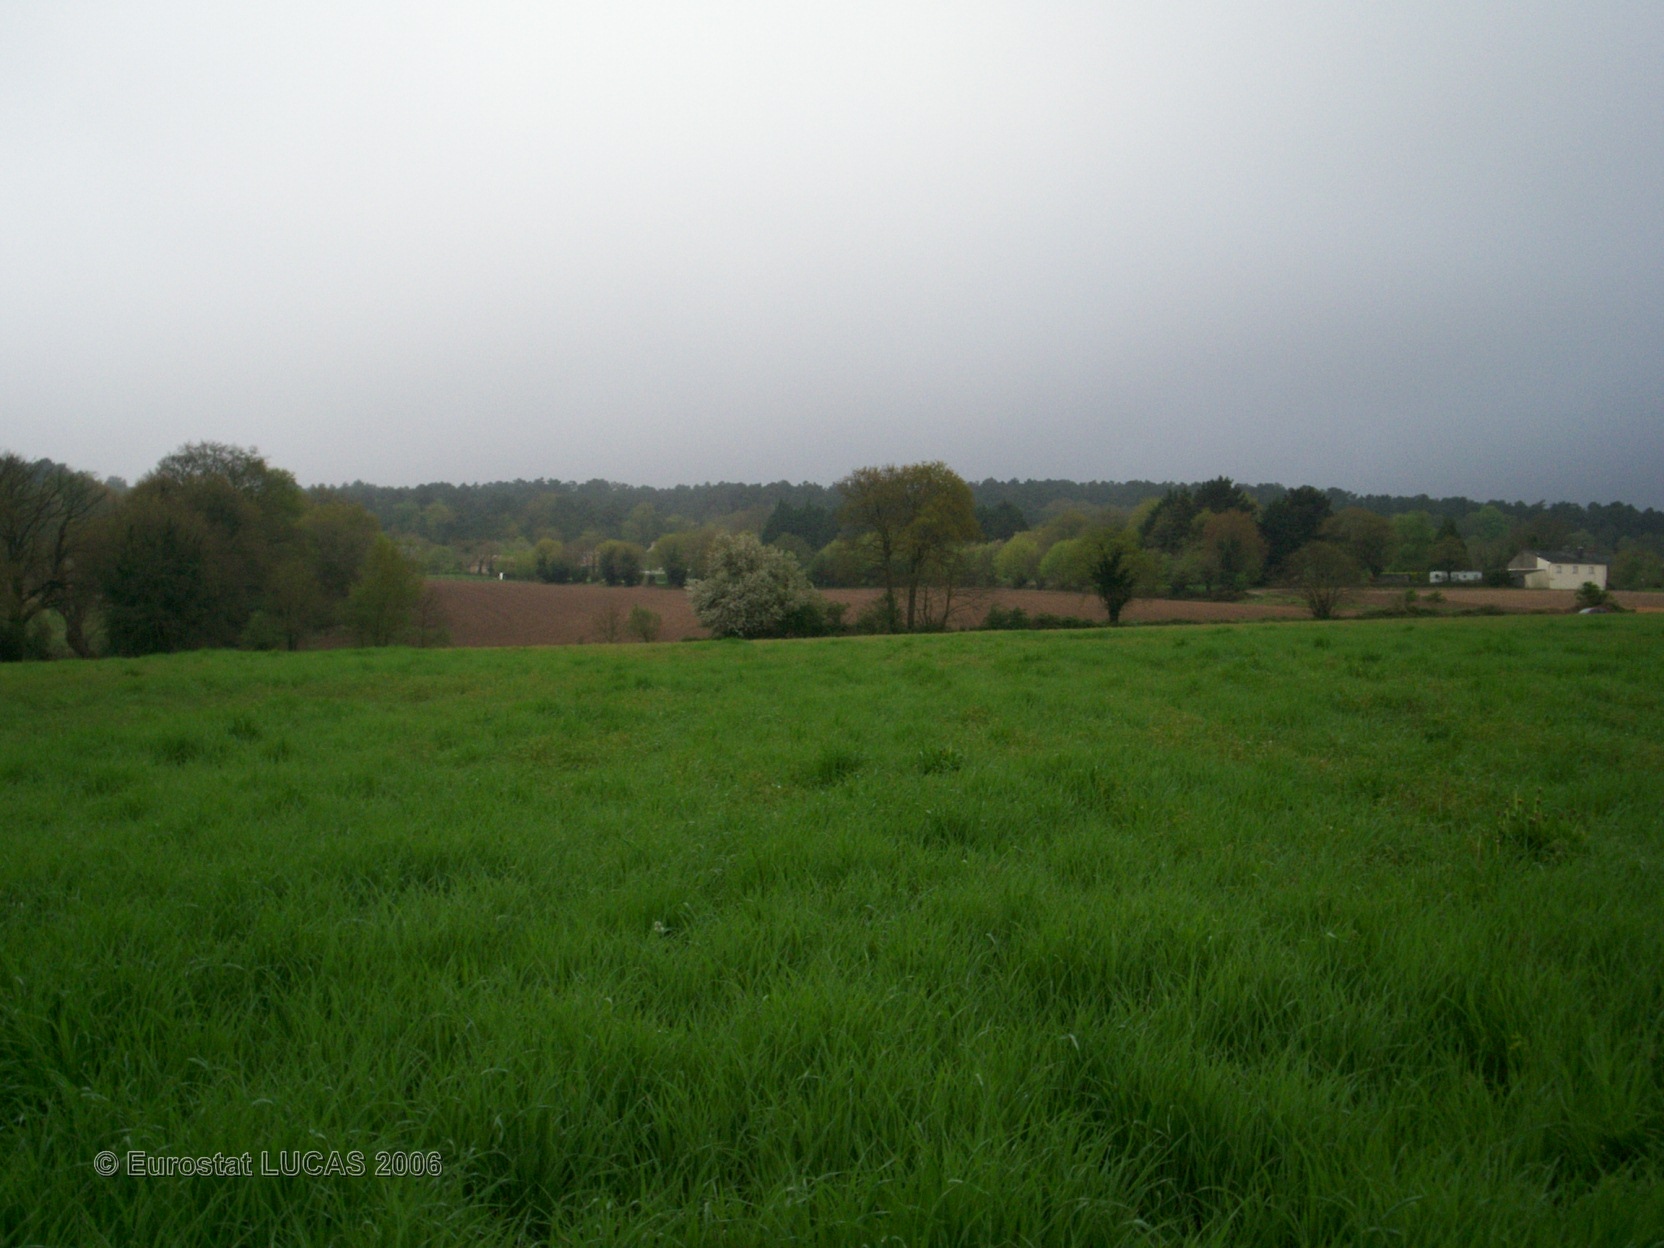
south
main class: Grassland
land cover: Grassland without tree/shrub cover
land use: Agriculture (excluding fallow land and kitchen gardens)
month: May
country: FR
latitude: 47.7500
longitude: -2.7742
